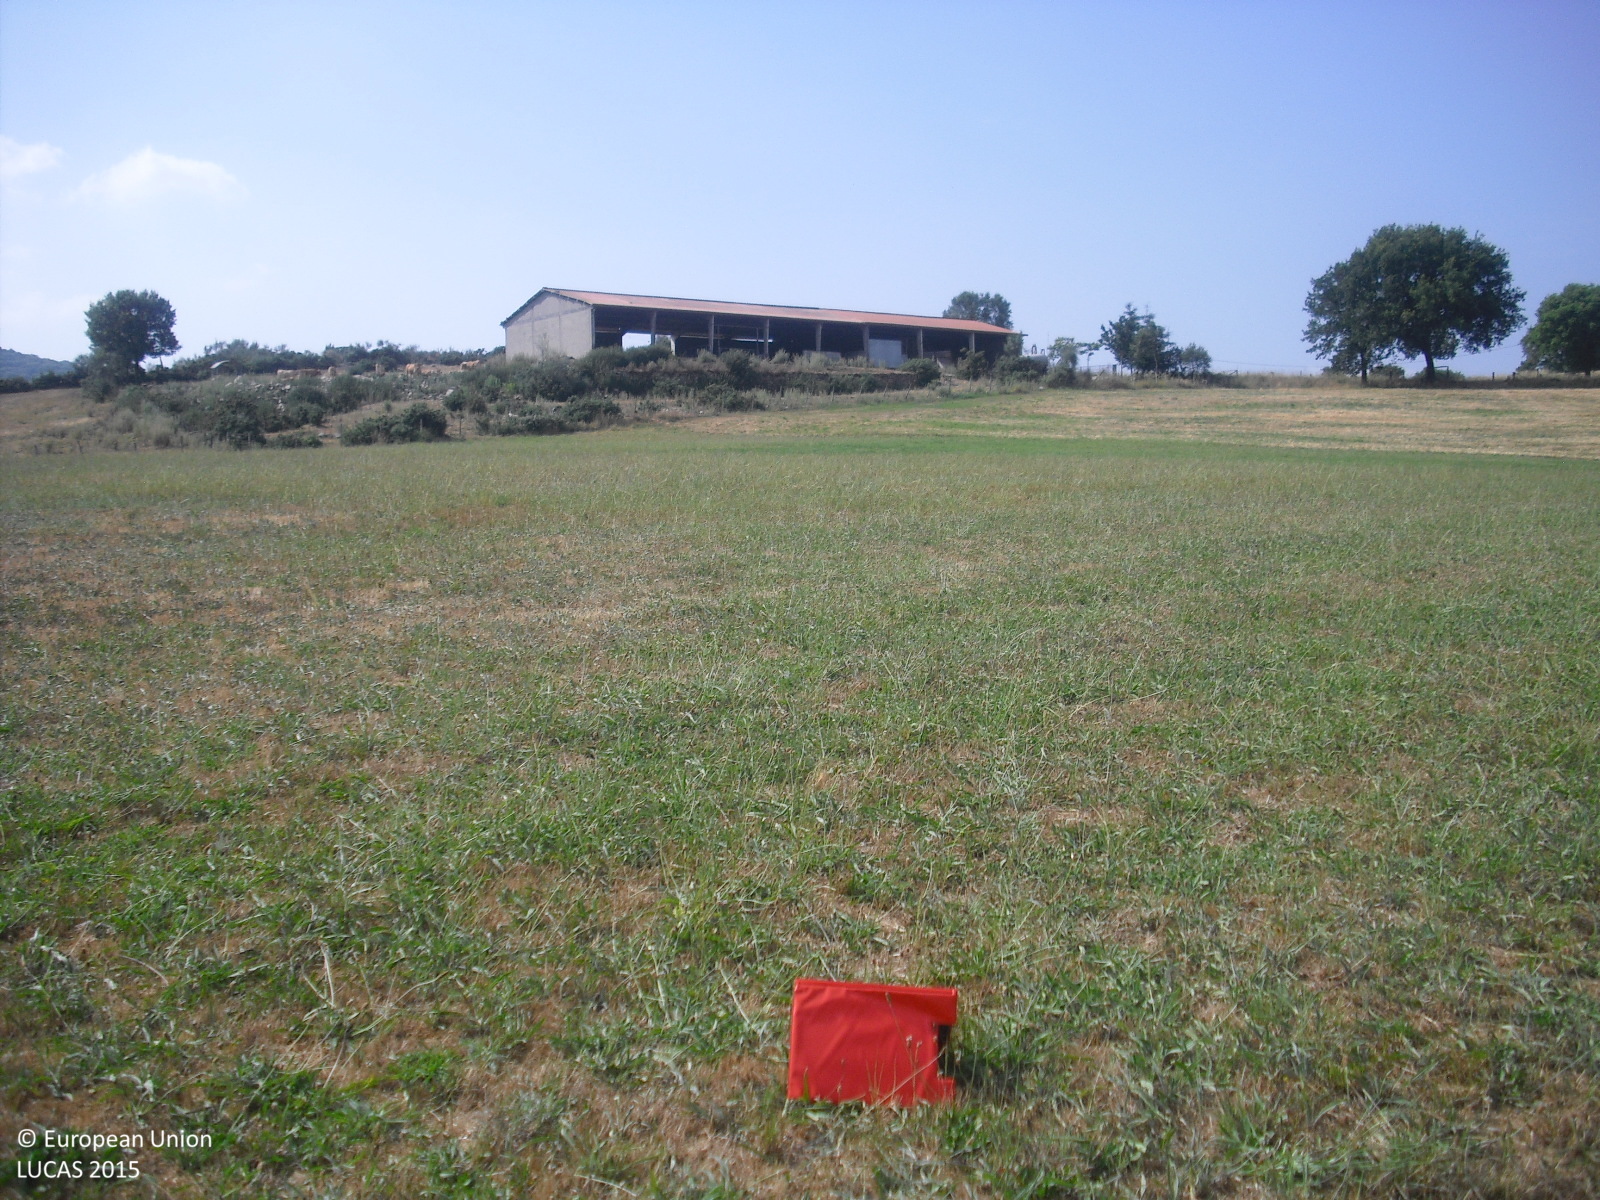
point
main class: Cropland
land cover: Temporary grasslands
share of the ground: > 75 %
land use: Agriculture (excluding fallow land and kitchen gardens)
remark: Clear cut
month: June
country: ES
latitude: 42.6223
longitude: -7.8446
